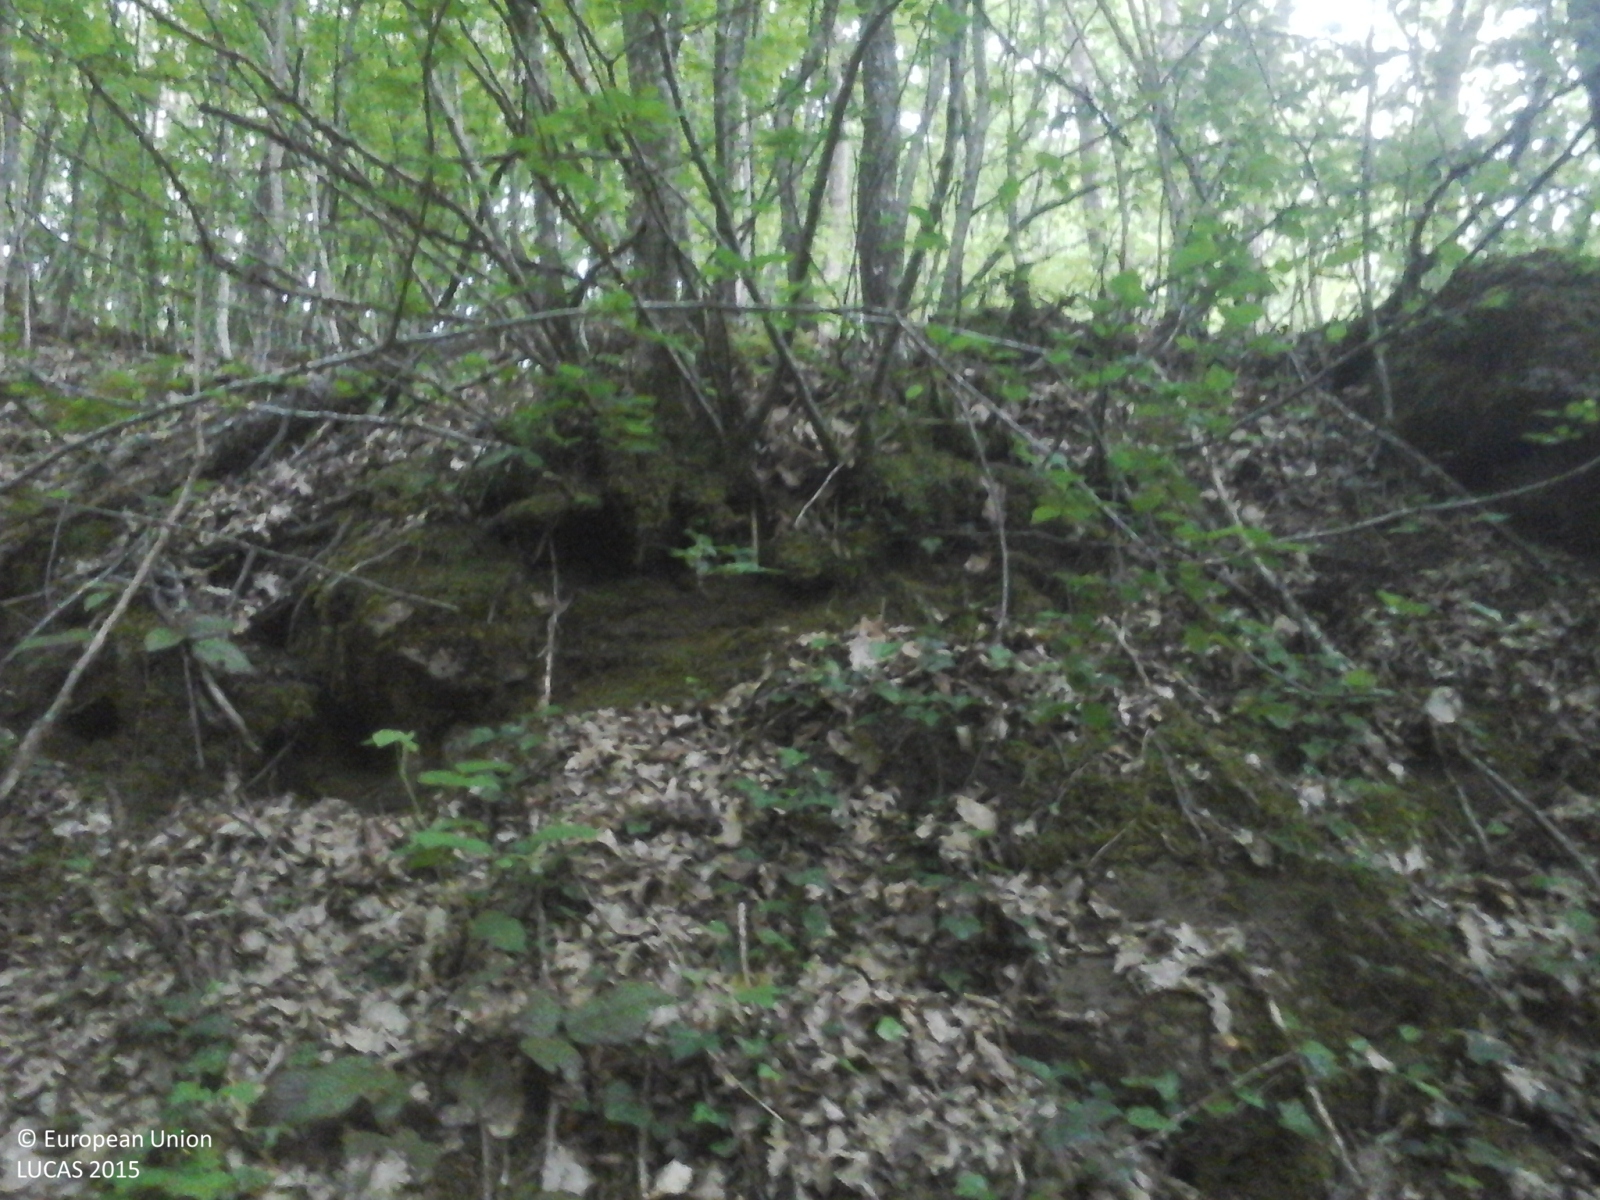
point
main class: Woodland
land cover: Broadleaved woodland
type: thermophilous deciduous forest
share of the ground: > 75 %
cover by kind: broadleaved forest trees 100 %
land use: Forestry
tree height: > 5 m
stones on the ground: 10 - 25 %
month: May
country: IT
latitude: 44.2739
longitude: 10.9625
